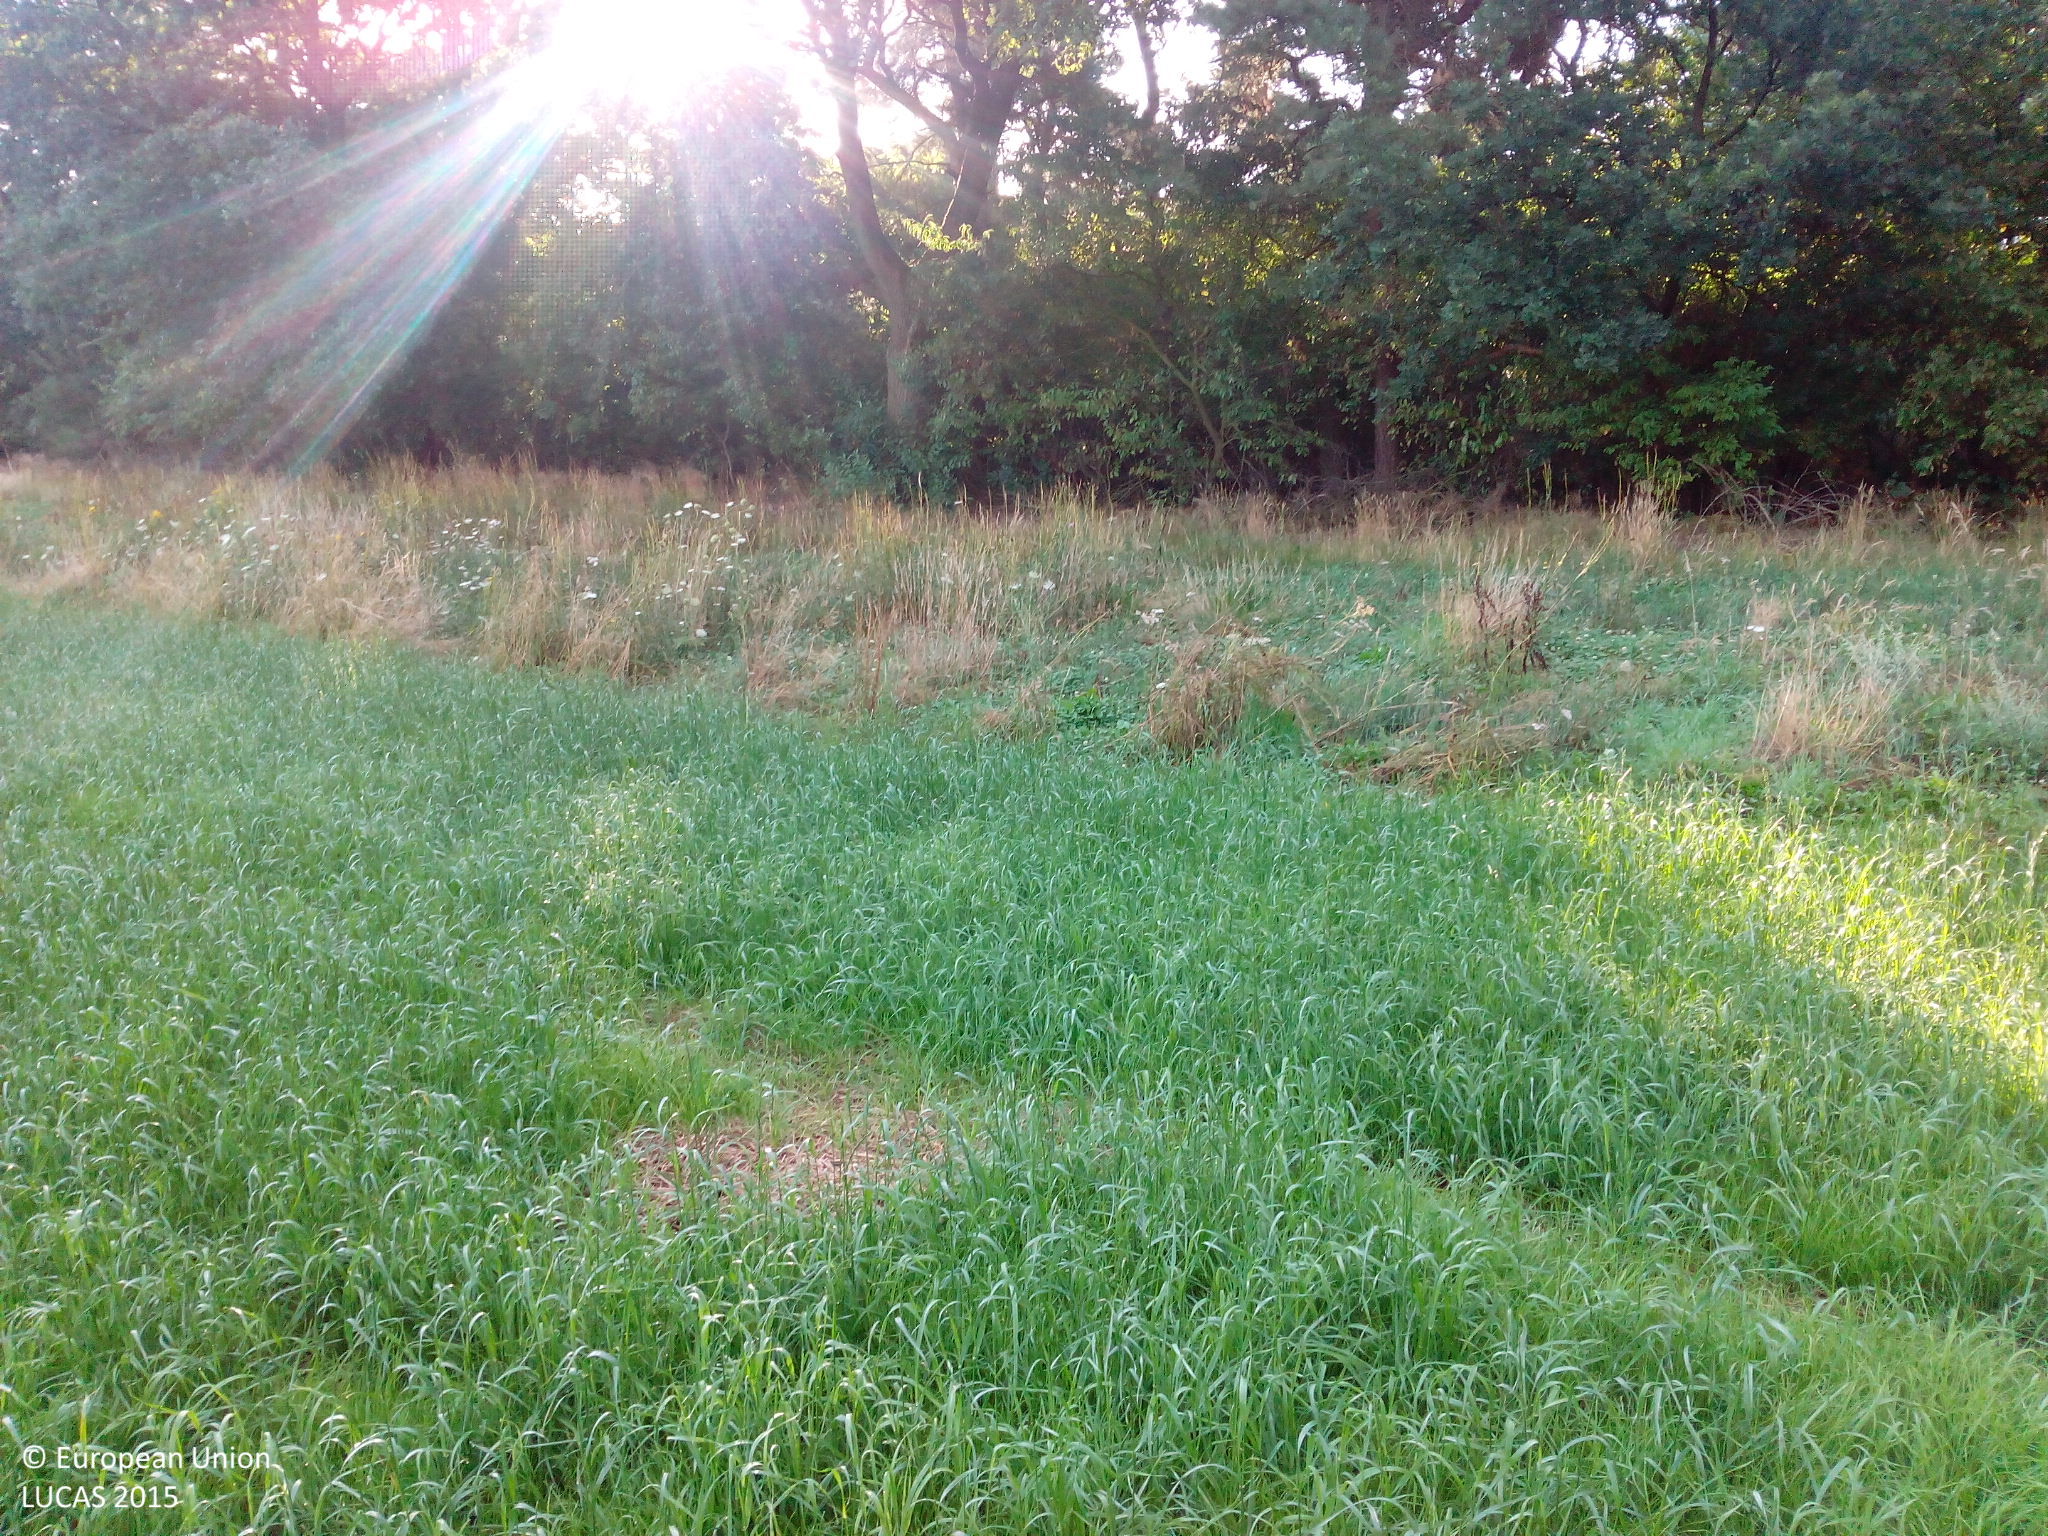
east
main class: Grassland
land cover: Grassland without tree/shrub cover
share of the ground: > 75 %
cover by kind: herbaceous plants 100 %
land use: Agriculture (excluding fallow land and kitchen gardens)
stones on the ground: < 10 %
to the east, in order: Grassland without tree/shrub cover; Fences; Pine dominated mixed woodland; Grass margins; Paved roads, cycling and walking lanes; Grass margins; Paved roads, cycling and walking lanes; Grass margins; Rape and turnip rape; Tracks; Groves; Fences; Pine dominated mixed woodland
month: August
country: NL
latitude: 51.2887
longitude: 5.6249
